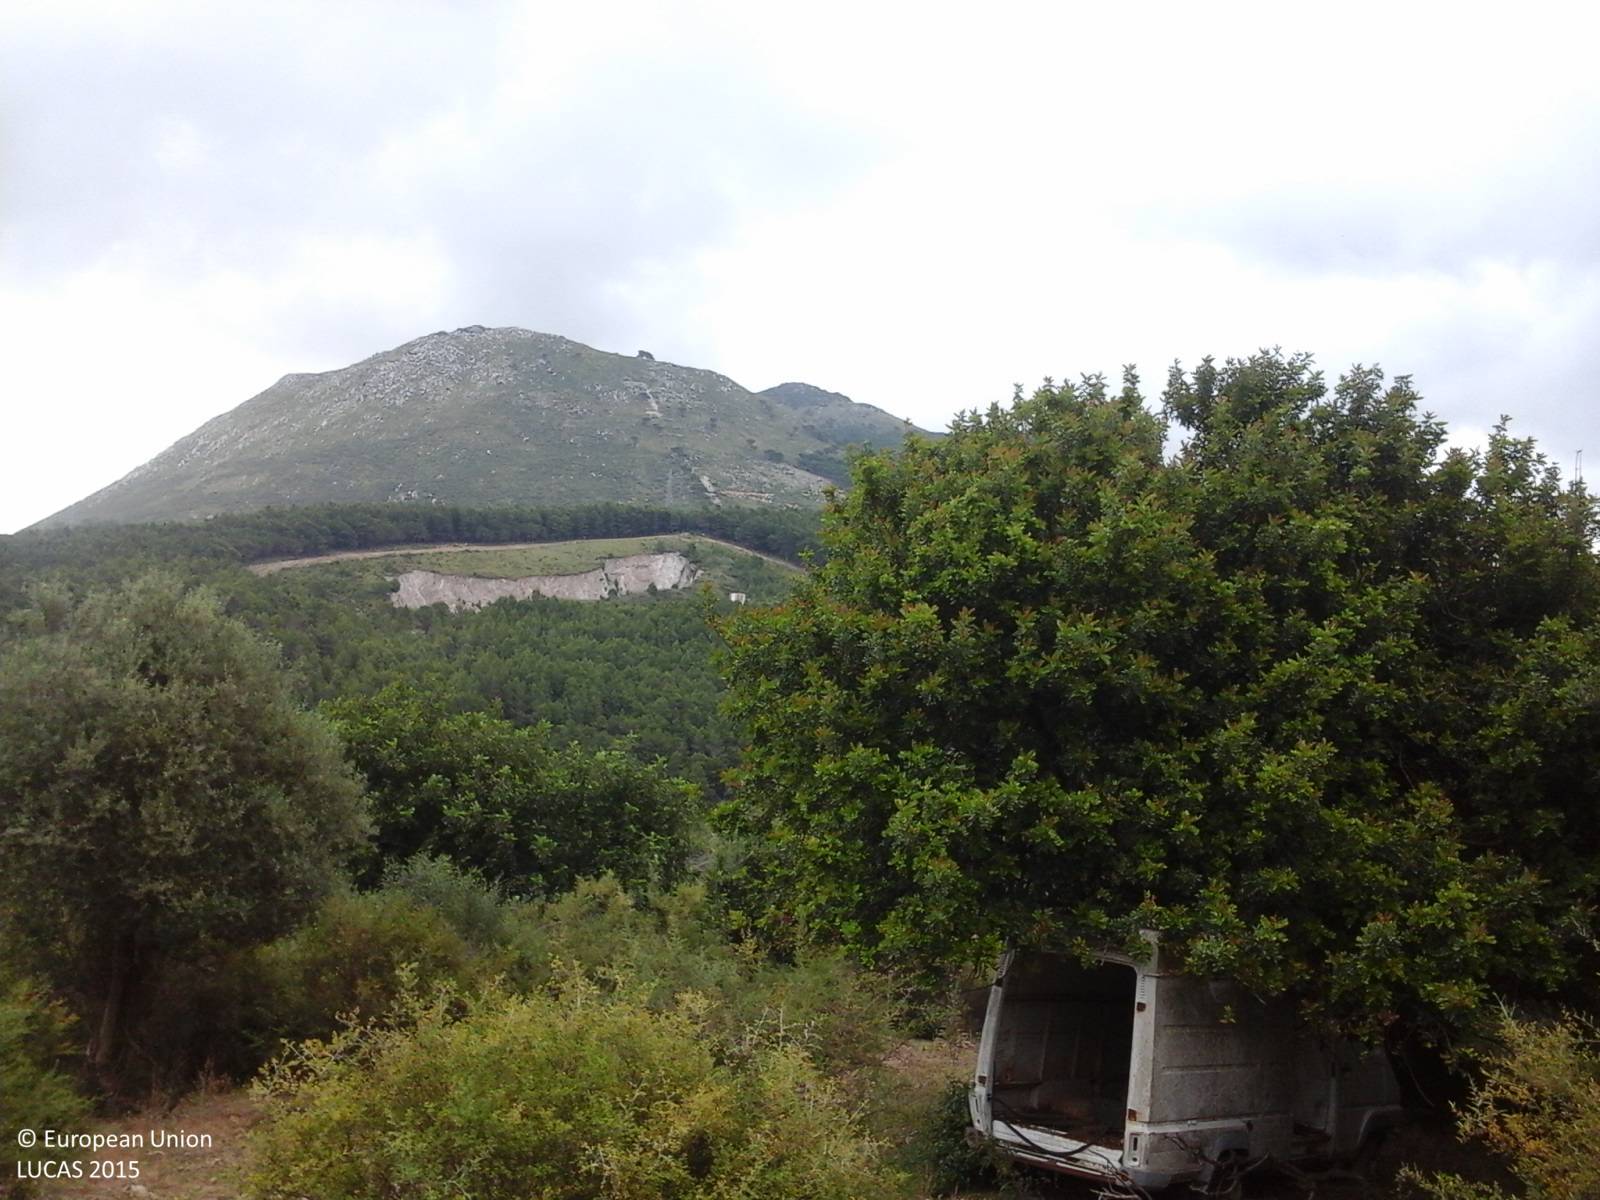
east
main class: Shrubland
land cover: Shrubland with sparse tree cover
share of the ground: > 75 %
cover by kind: herbaceous plants 75 %, shrubs 20 %, broadleaved forest trees 5 %
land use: Abandoned areas
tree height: < 5 m
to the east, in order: Shrubland with sparse tree cover; Grassland with sparse tree/shrub cover; Shrubland with sparse tree cover; Grassland with sparse tree/shrub cover
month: June
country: IT
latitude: 38.1128
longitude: 13.1599
